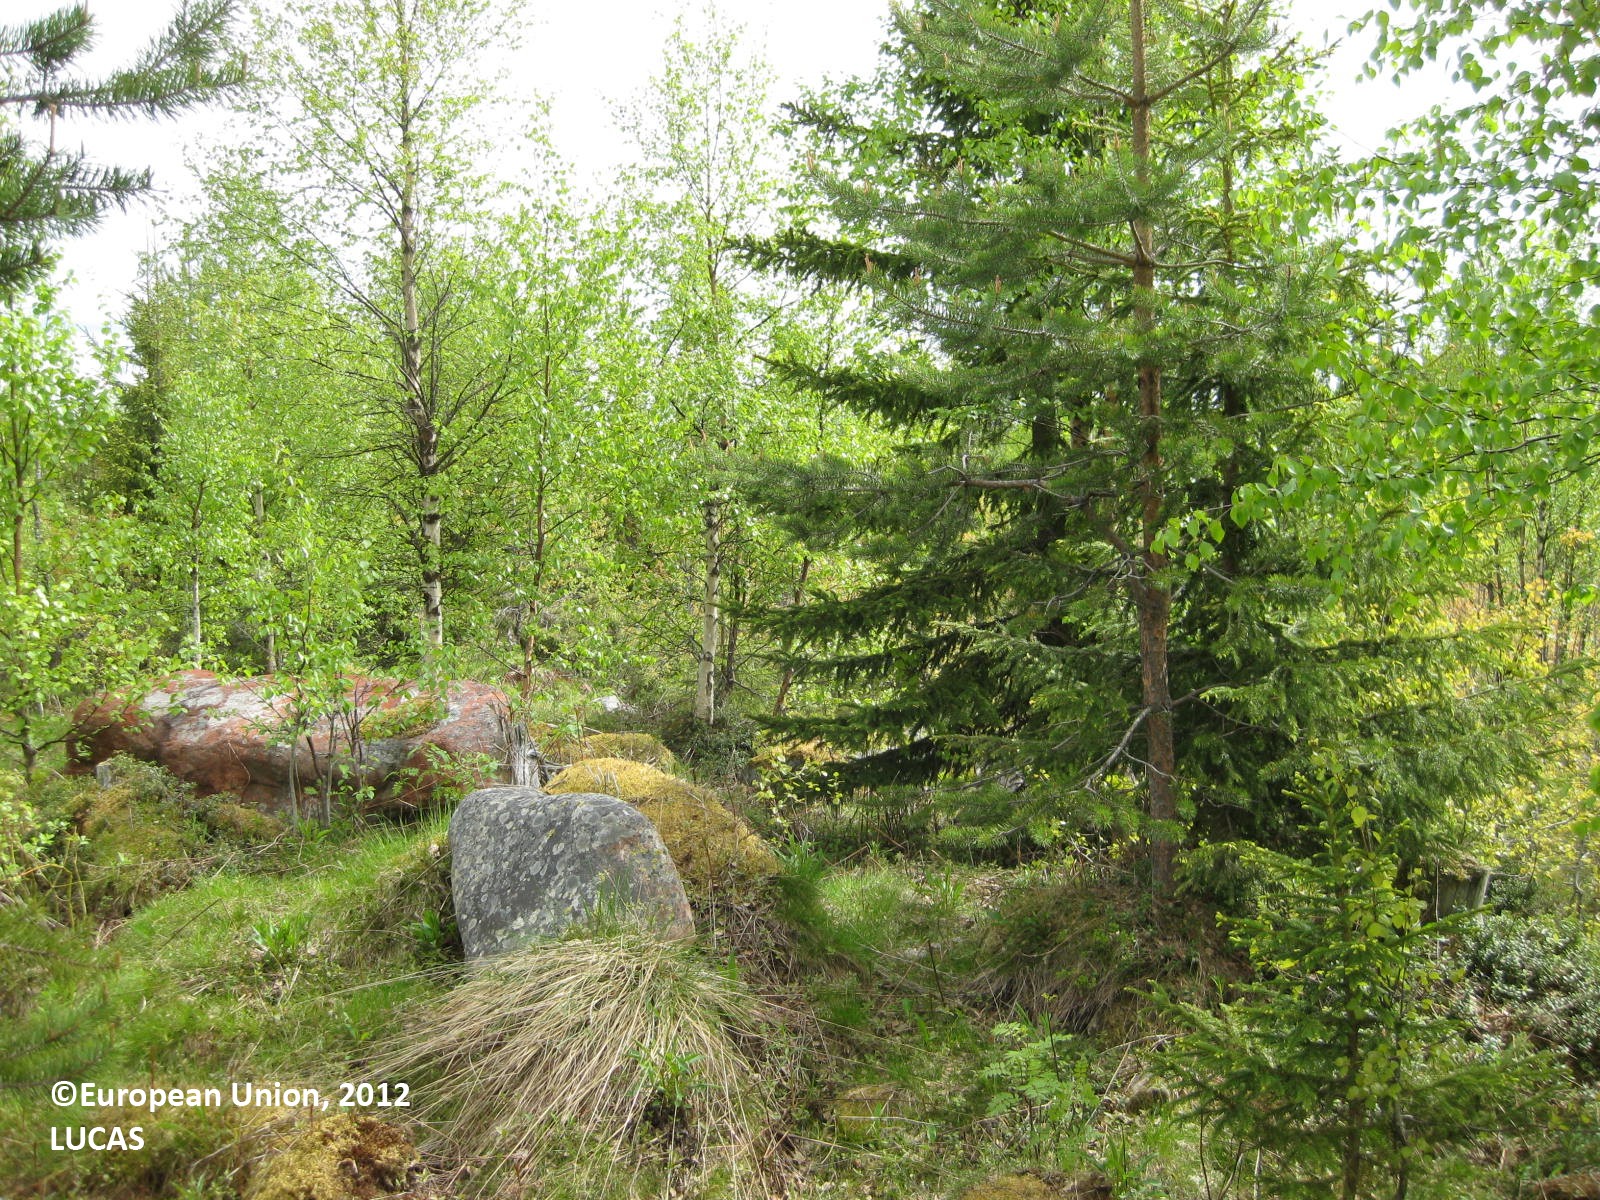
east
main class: Woodland
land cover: Broadleaved woodland
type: boreal forest
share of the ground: 50 - 75 %
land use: Forestry
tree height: > 5 m
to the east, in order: Broadleaved woodland; Other mixed woodland; Broadleaved woodland; Spruce dominated mixed woodland; Broadleaved woodland
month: June
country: FI
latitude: 65.1894
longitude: 28.9118
